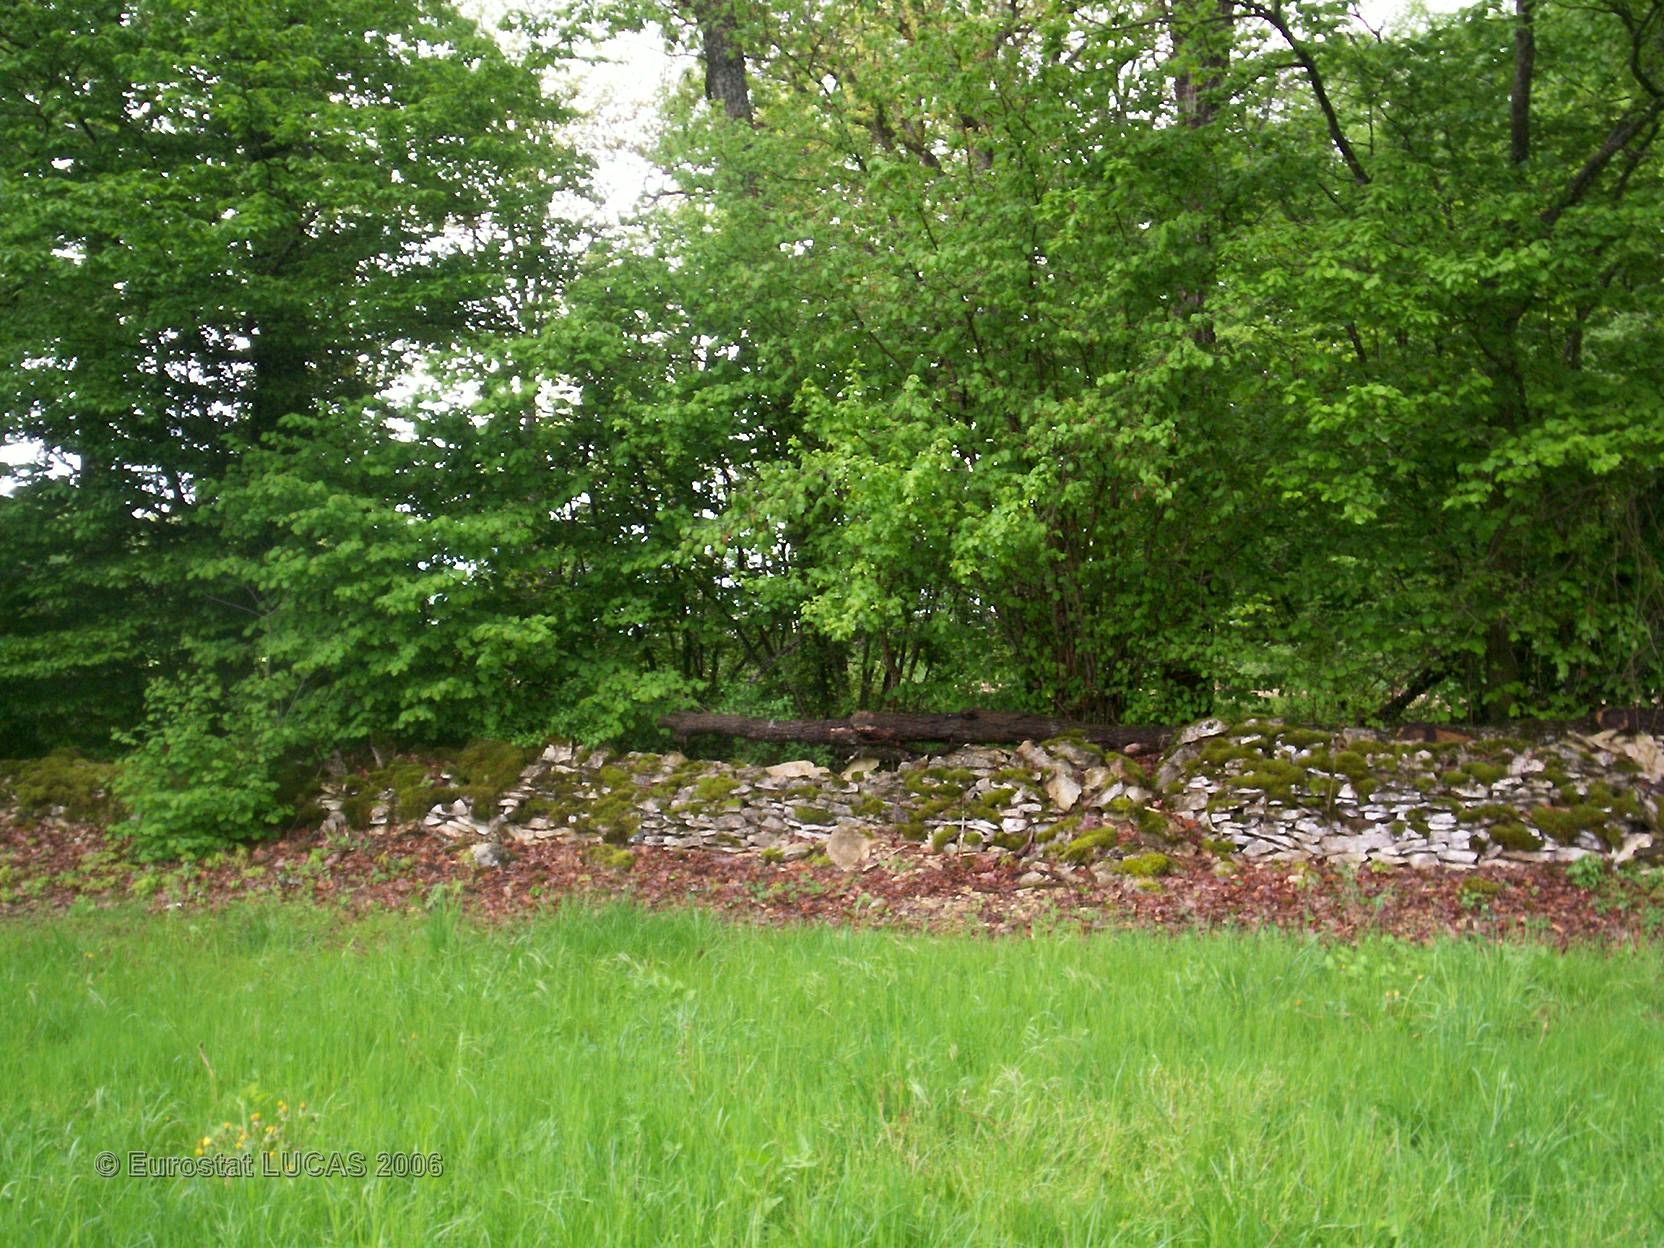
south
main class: Grassland
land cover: Grassland without tree/shrub cover
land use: Agriculture (excluding fallow land and kitchen gardens)
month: May
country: FR
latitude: 47.7663
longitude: 4.5950
